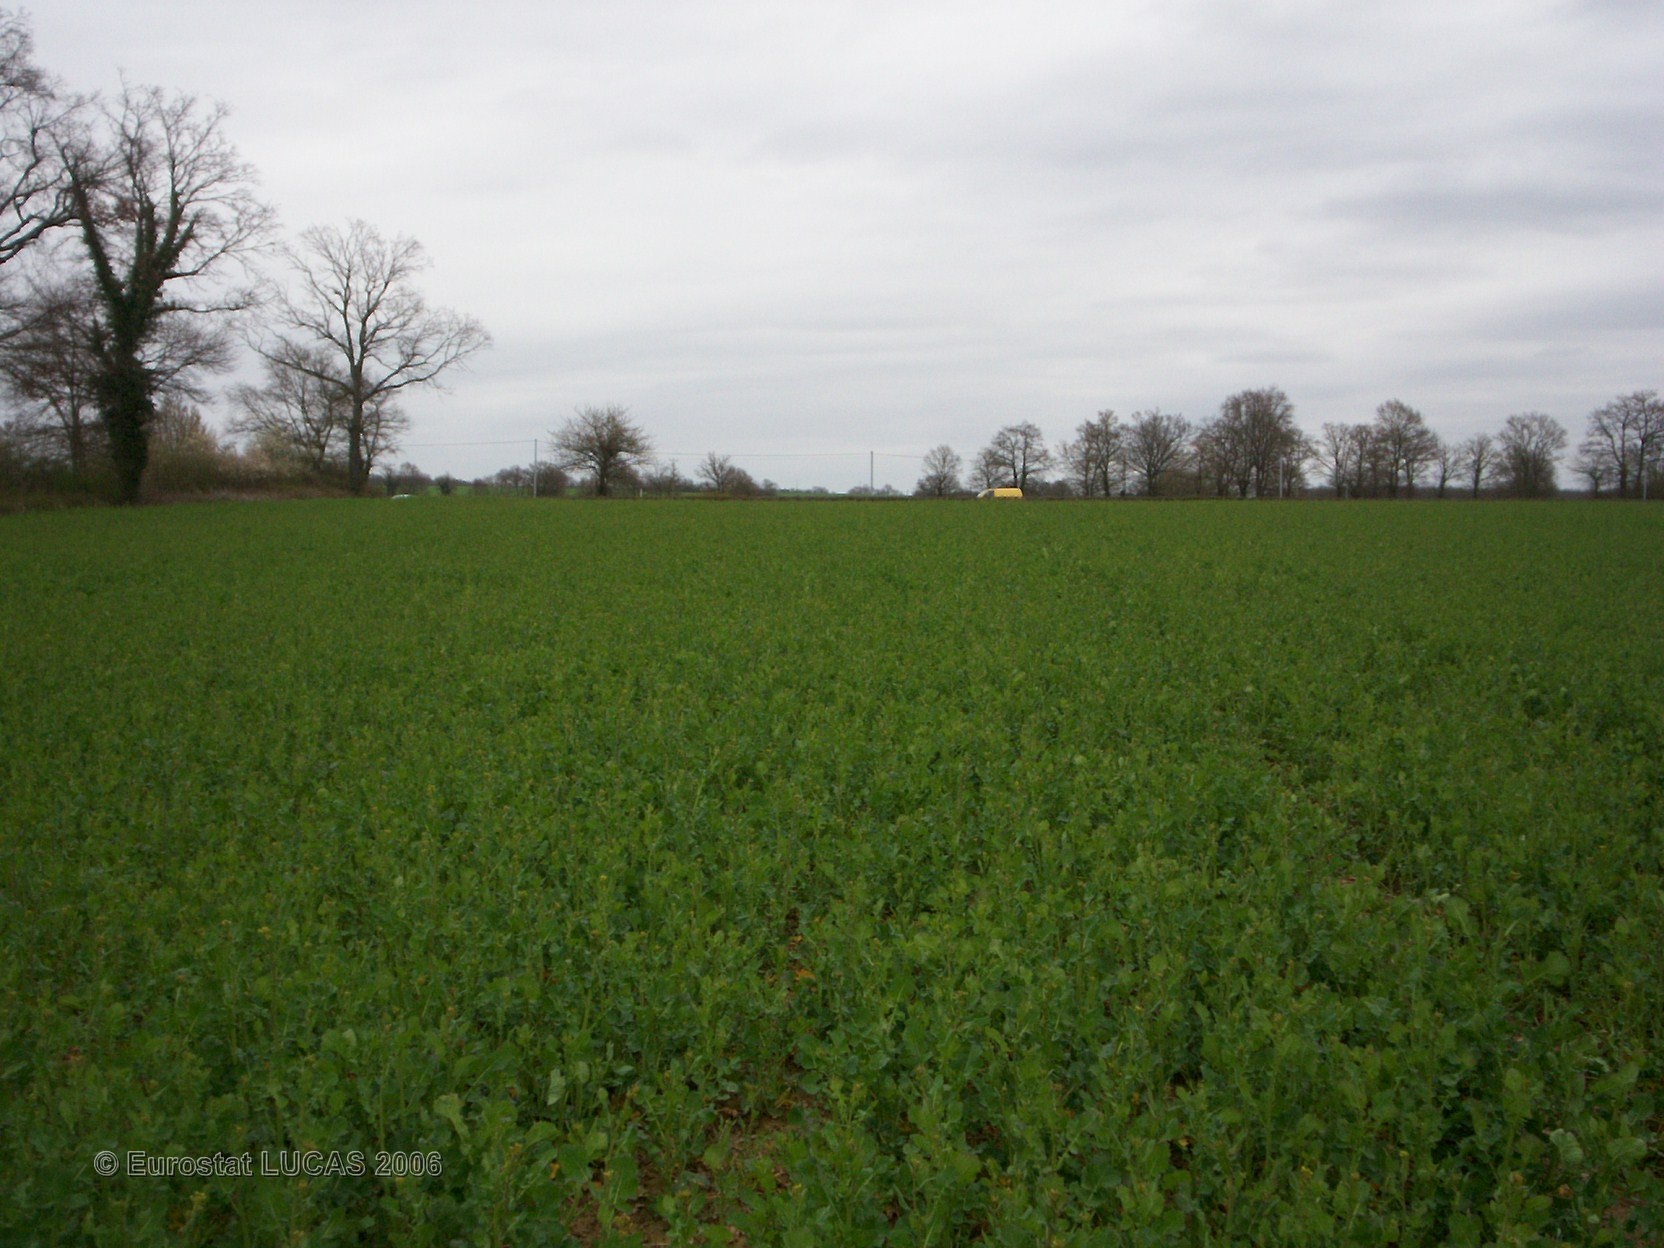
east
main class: Cropland
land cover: Rape and turnip rape
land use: Agriculture (excluding fallow land and kitchen gardens)
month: April
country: FR
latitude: 46.7035
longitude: 3.0517
